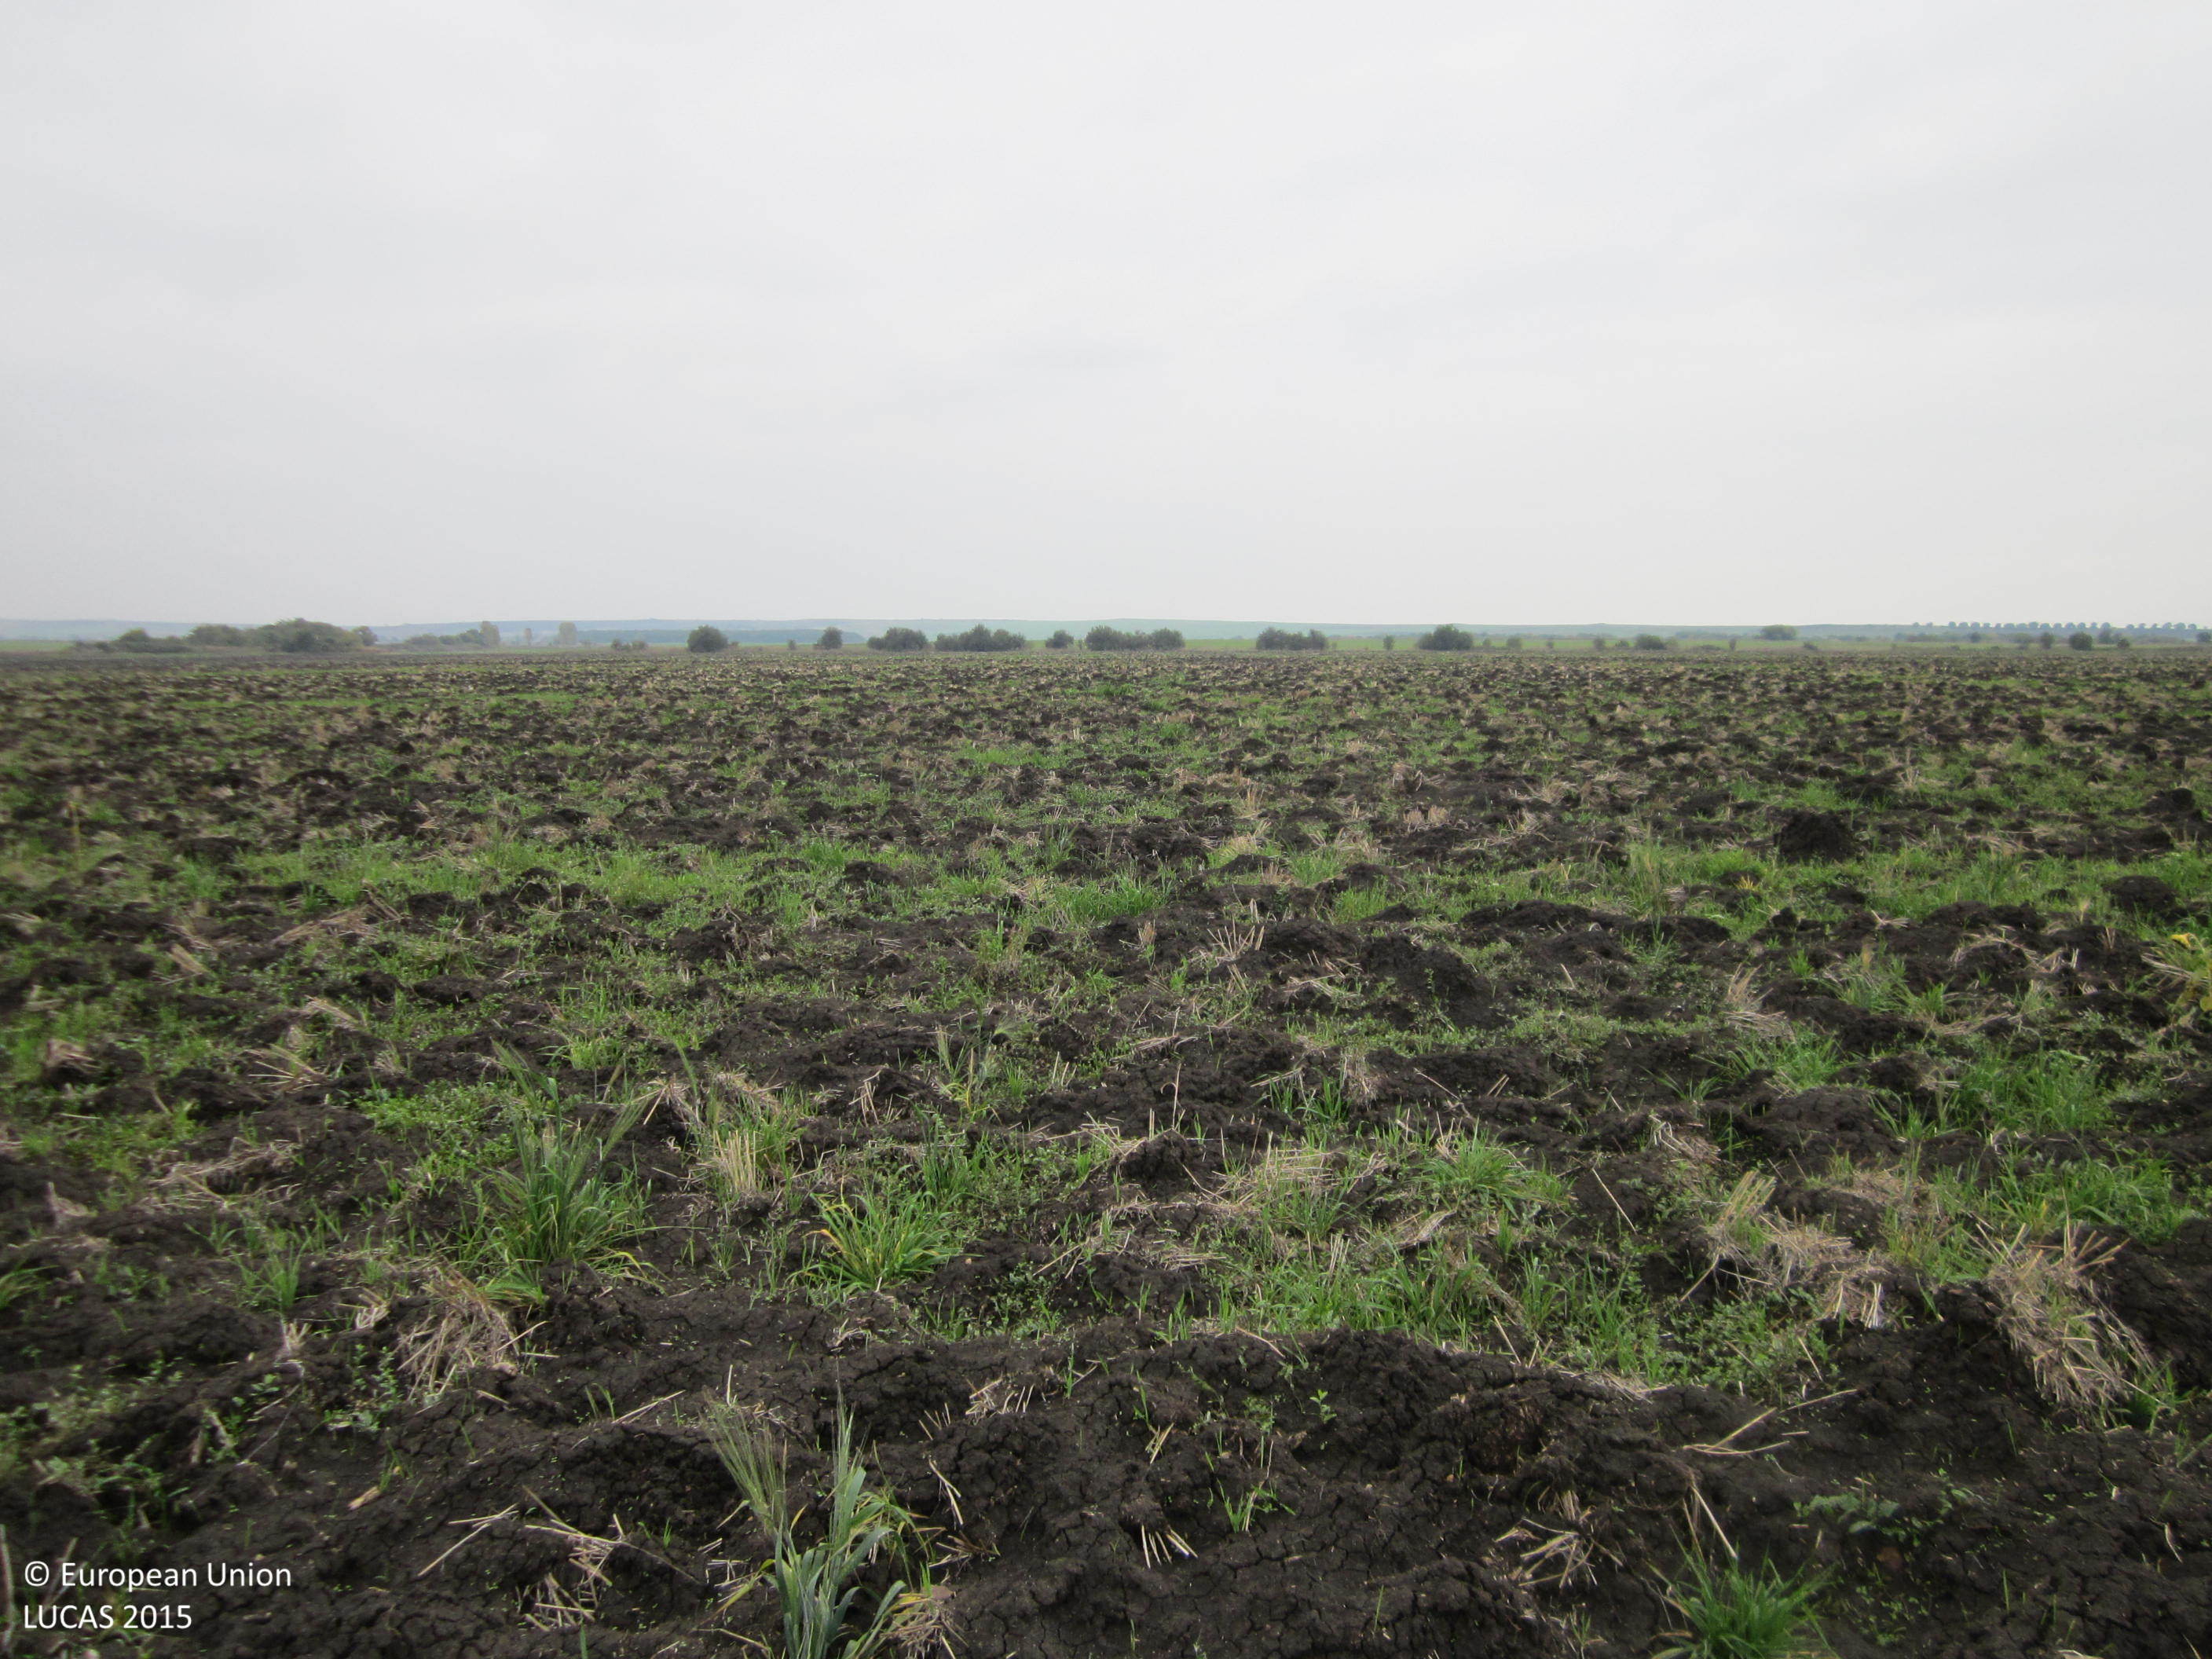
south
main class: Cropland
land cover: Barley
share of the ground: < 10 %
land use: Agriculture (excluding fallow land and kitchen gardens)
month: October
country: BG
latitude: 42.5476
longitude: 27.2208
